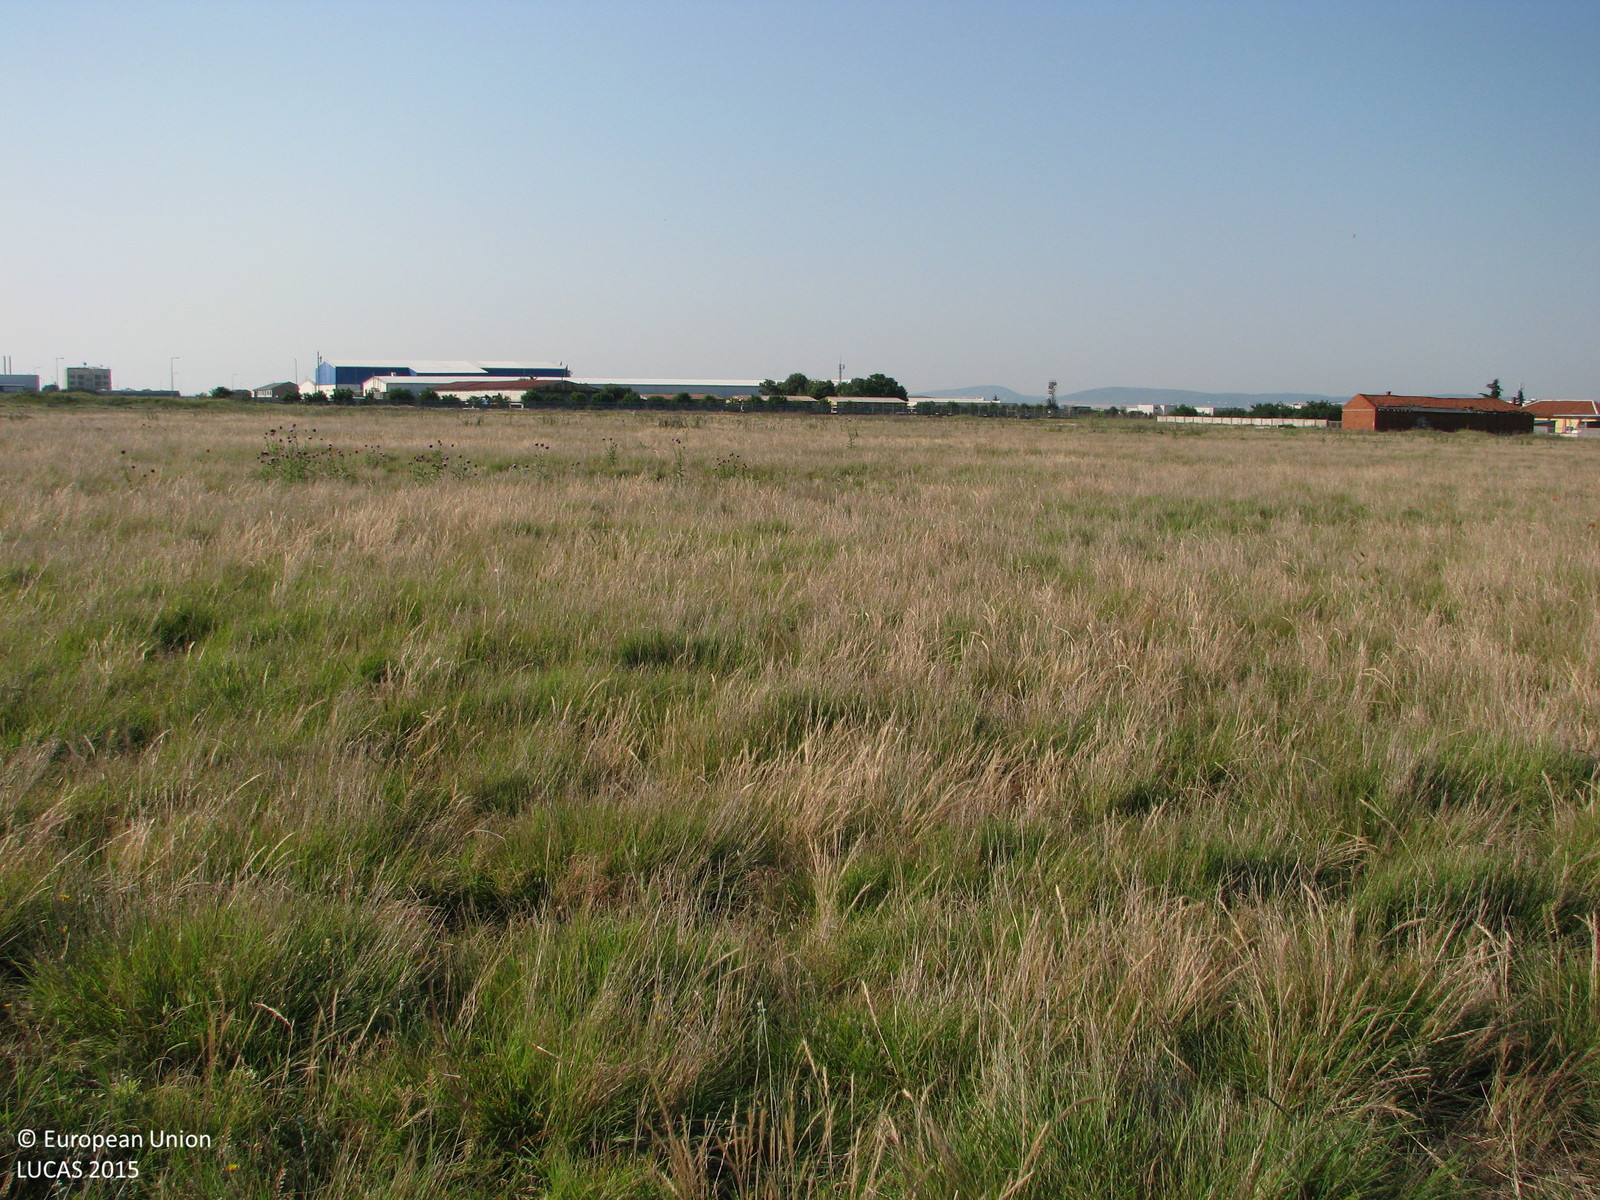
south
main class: Grassland
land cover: Grassland without tree/shrub cover
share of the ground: > 75 %
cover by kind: herbaceous plants 100 %
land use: Agriculture (excluding fallow land and kitchen gardens)
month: June
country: BG
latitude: 42.6470
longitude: 26.2995
